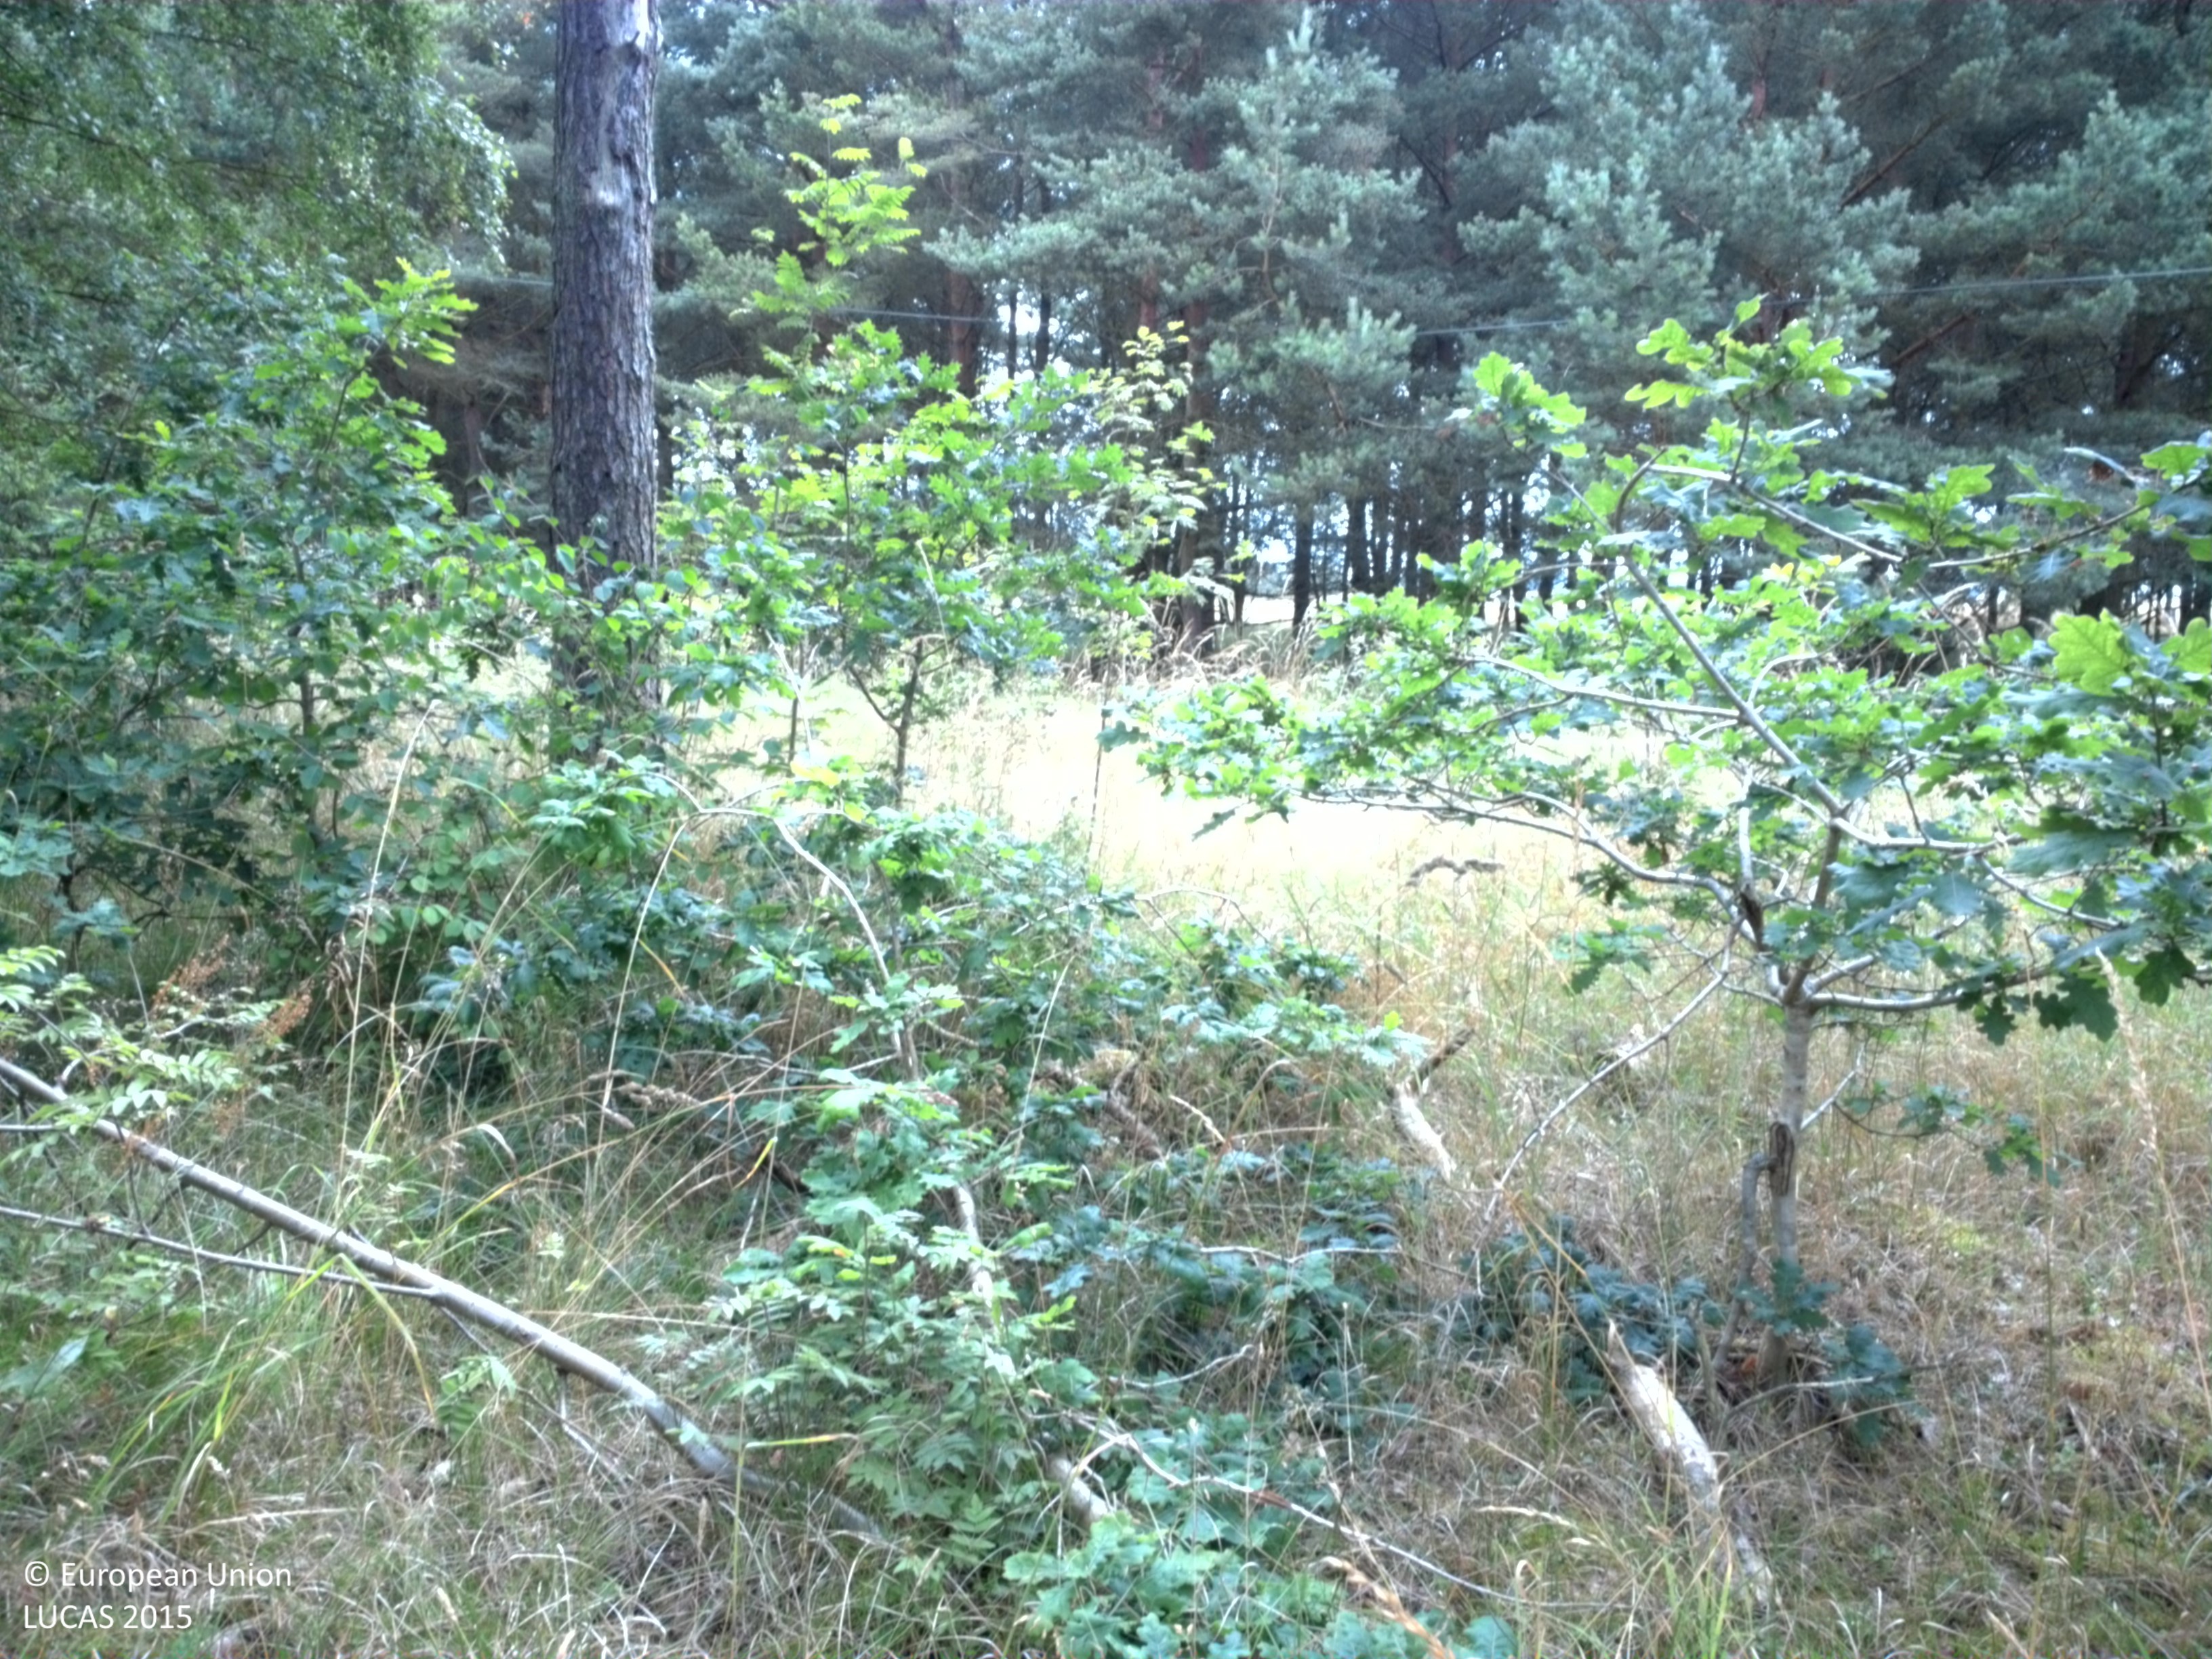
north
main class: Woodland
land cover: Pine dominated mixed woodland
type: hemiboreal forest and nemoral coniferous forest and mixed broadleaved-coniferous forest
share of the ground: > 75 %
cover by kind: coniferous forest trees 50 %, broadleaved forest trees 25 %, herbaceous plants 20 %, shrubs 5 %
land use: Forestry
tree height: > 5 m
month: July
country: SE
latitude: 57.2328
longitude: 18.6749
